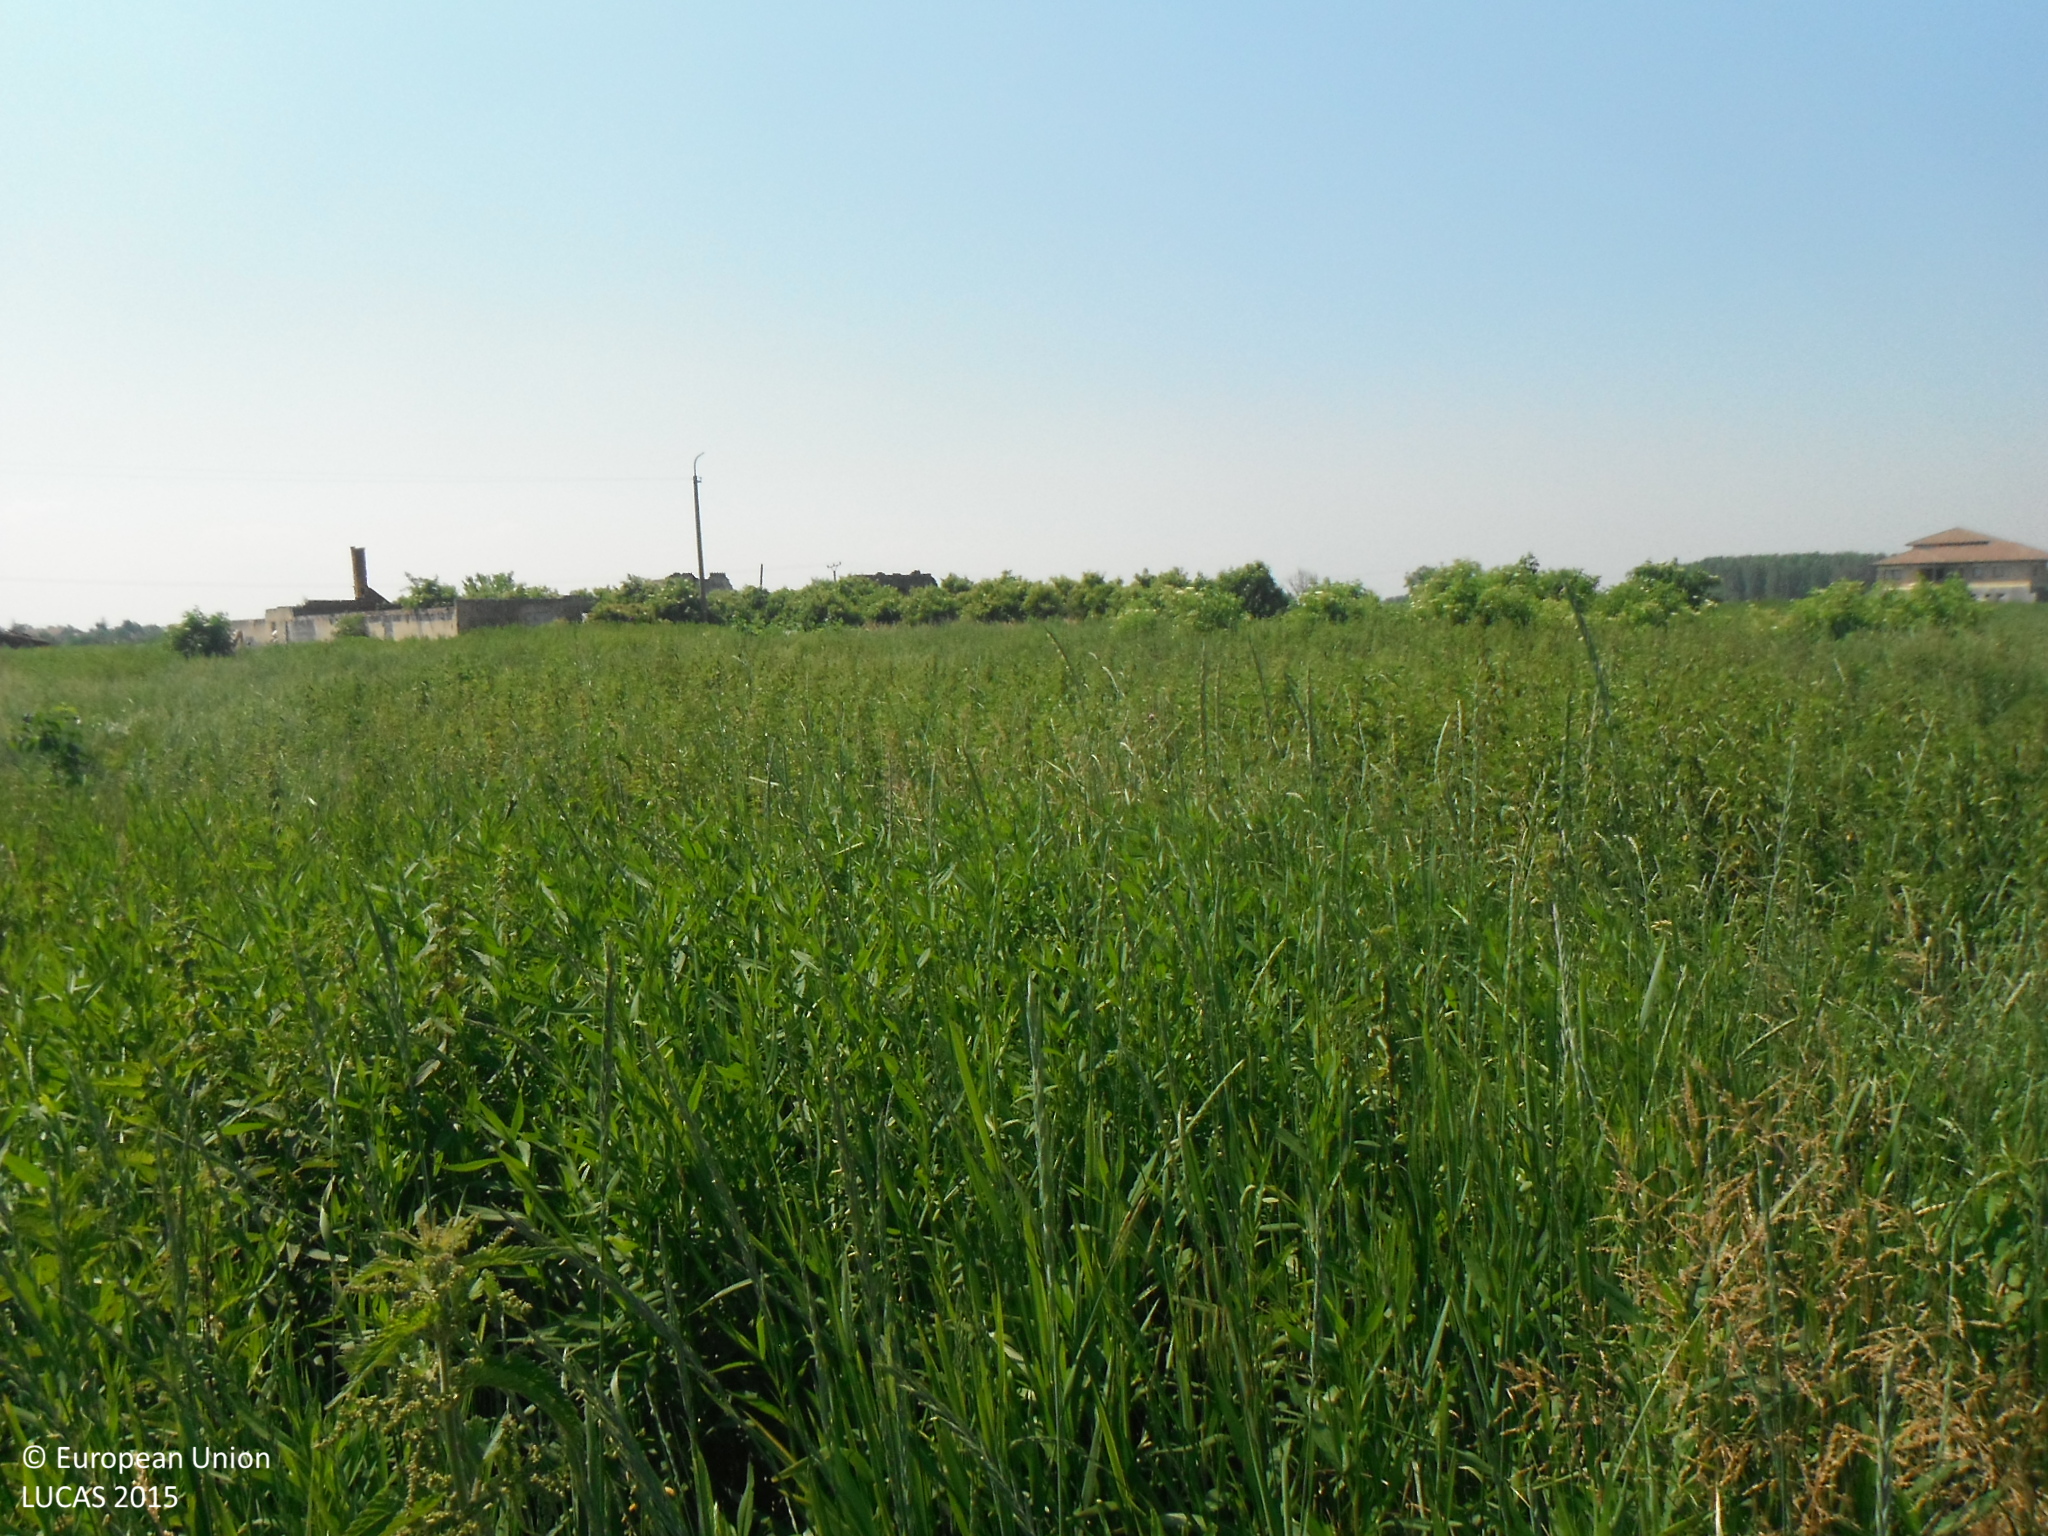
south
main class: Shrubland
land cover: Shrubland without tree cover
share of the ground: > 75 %
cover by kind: herbaceous plants 80 %, shrubs 20 %
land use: Abandoned areas
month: June
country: SK
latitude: 48.0454
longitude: 17.9399
